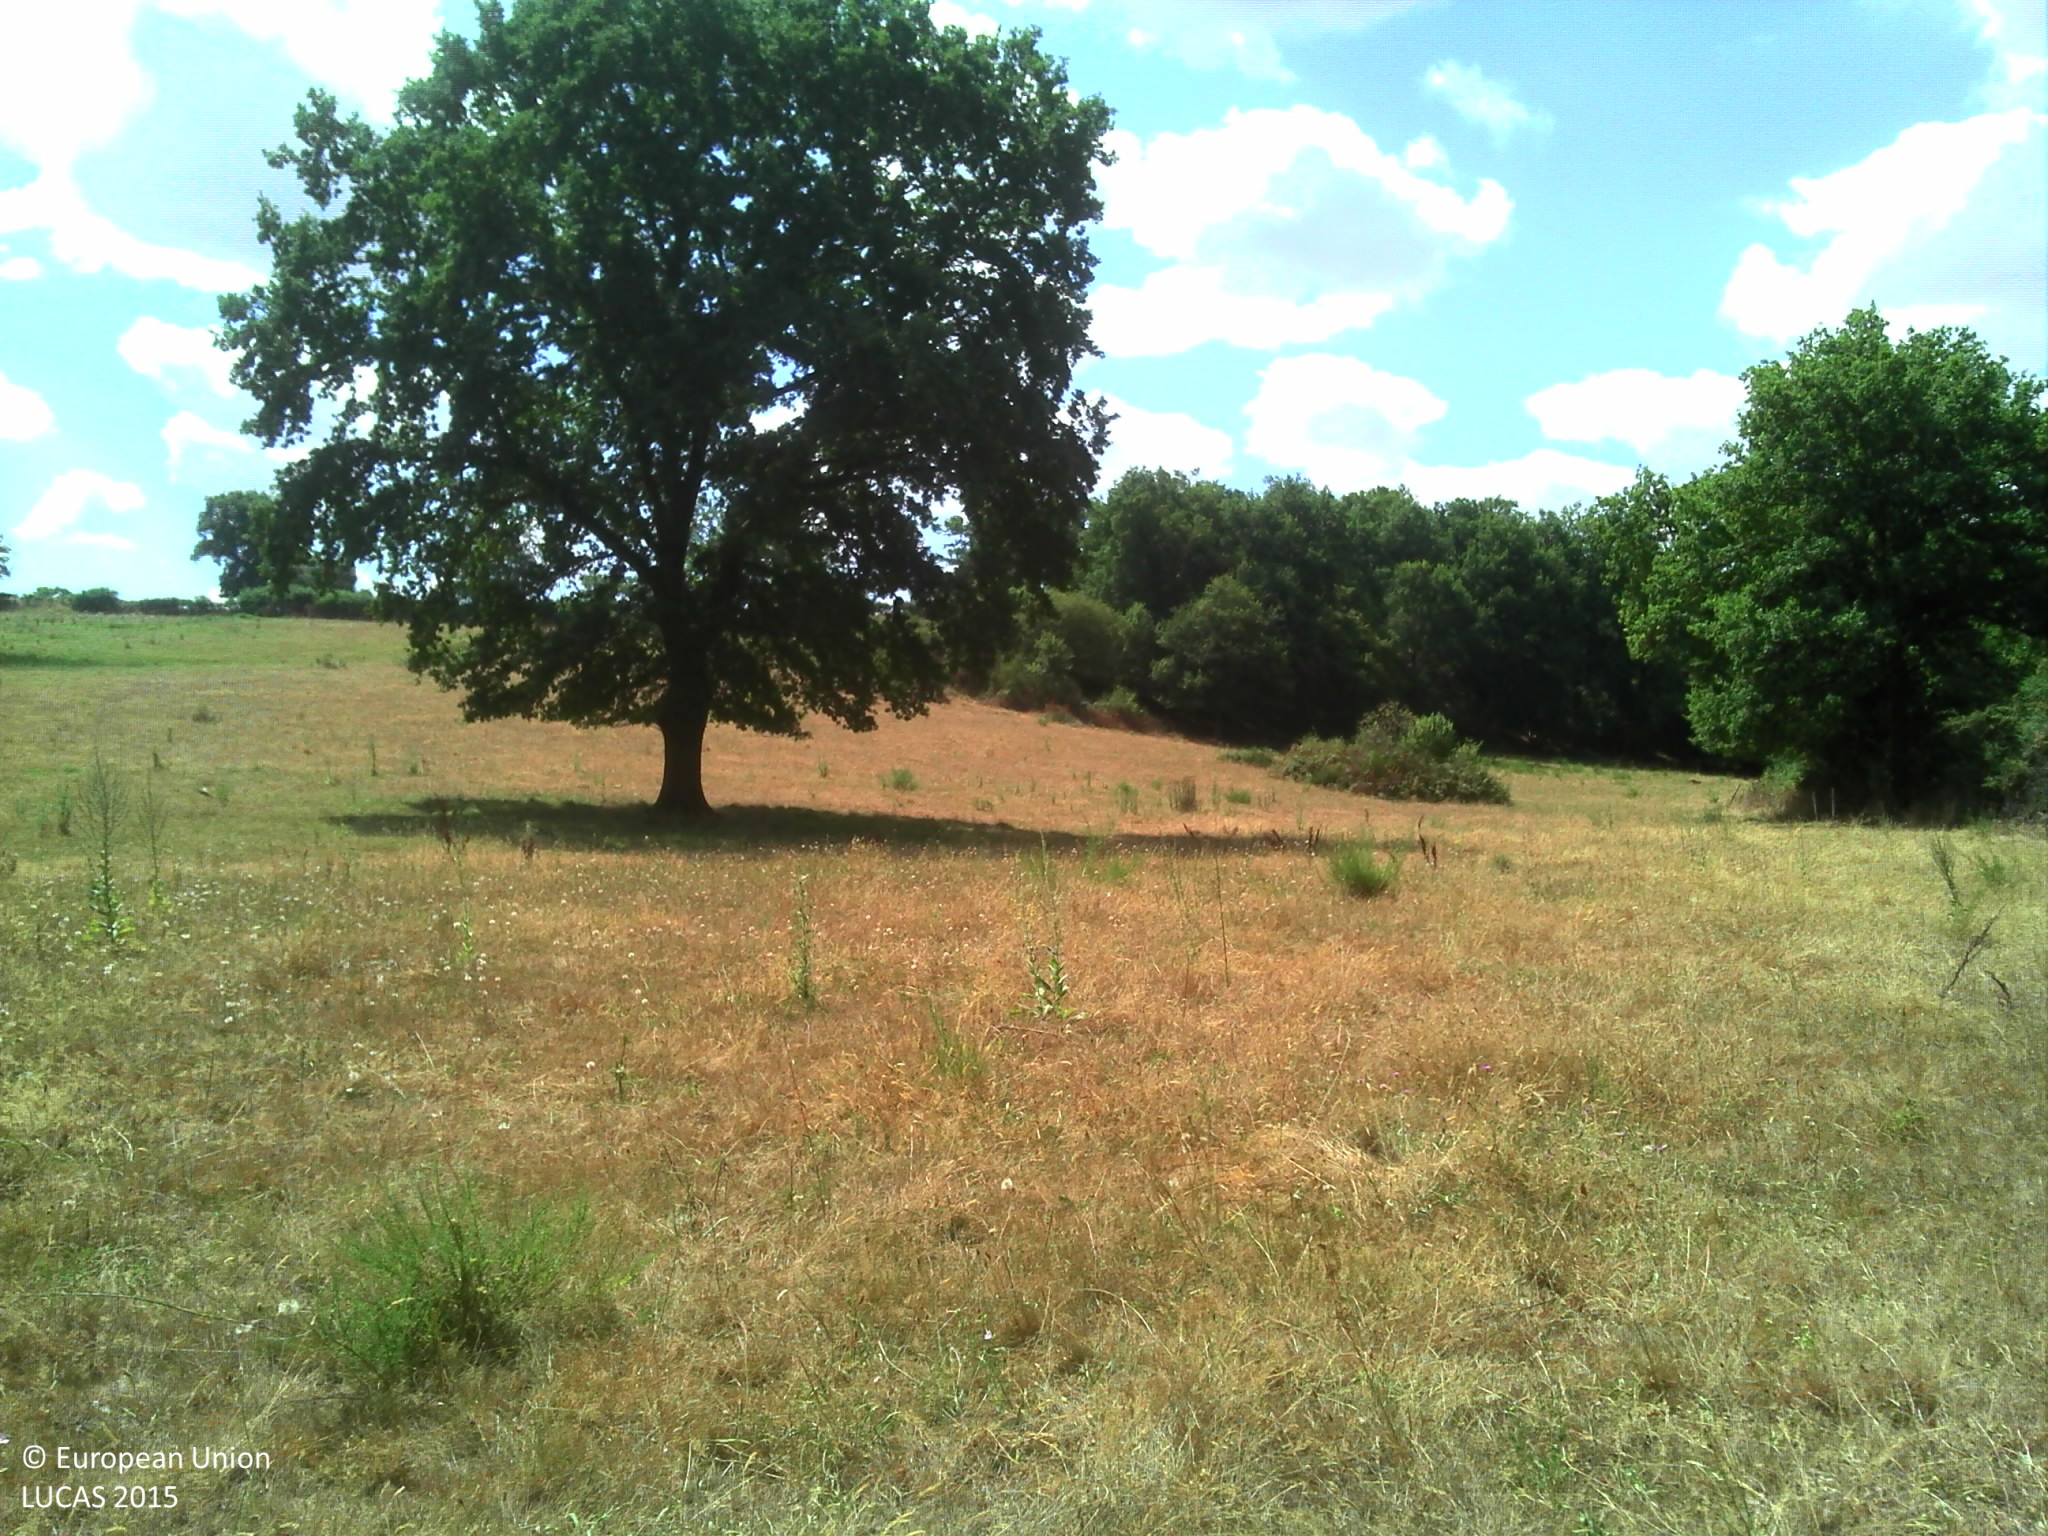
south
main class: Grassland
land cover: Grassland without tree/shrub cover
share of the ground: > 75 %
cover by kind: herbaceous plants 100 %
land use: Agriculture (excluding fallow land and kitchen gardens)
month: July
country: FR
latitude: 46.4661
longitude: 2.7429
